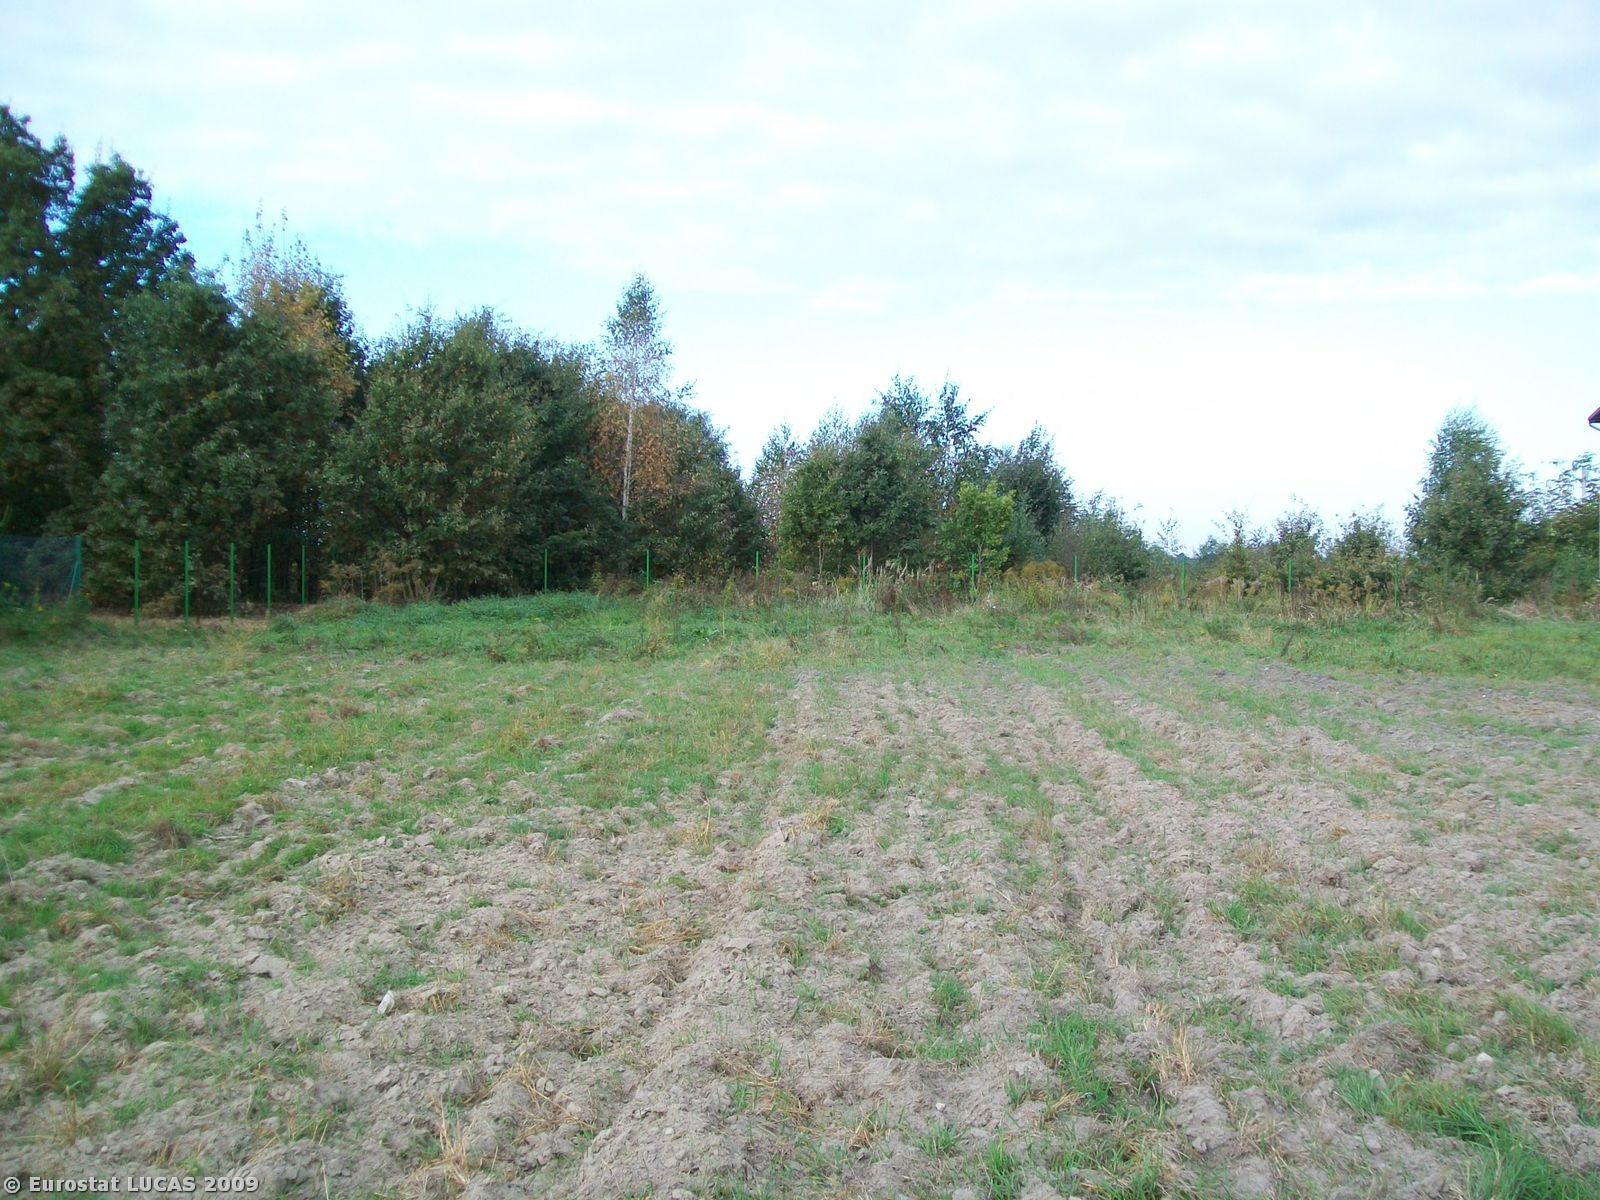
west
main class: Grassland
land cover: Grassland without tree/shrub cover
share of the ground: < 10 %
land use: Agriculture (excluding fallow land and kitchen gardens)
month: September
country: PL
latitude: 52.1895
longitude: 20.8228
